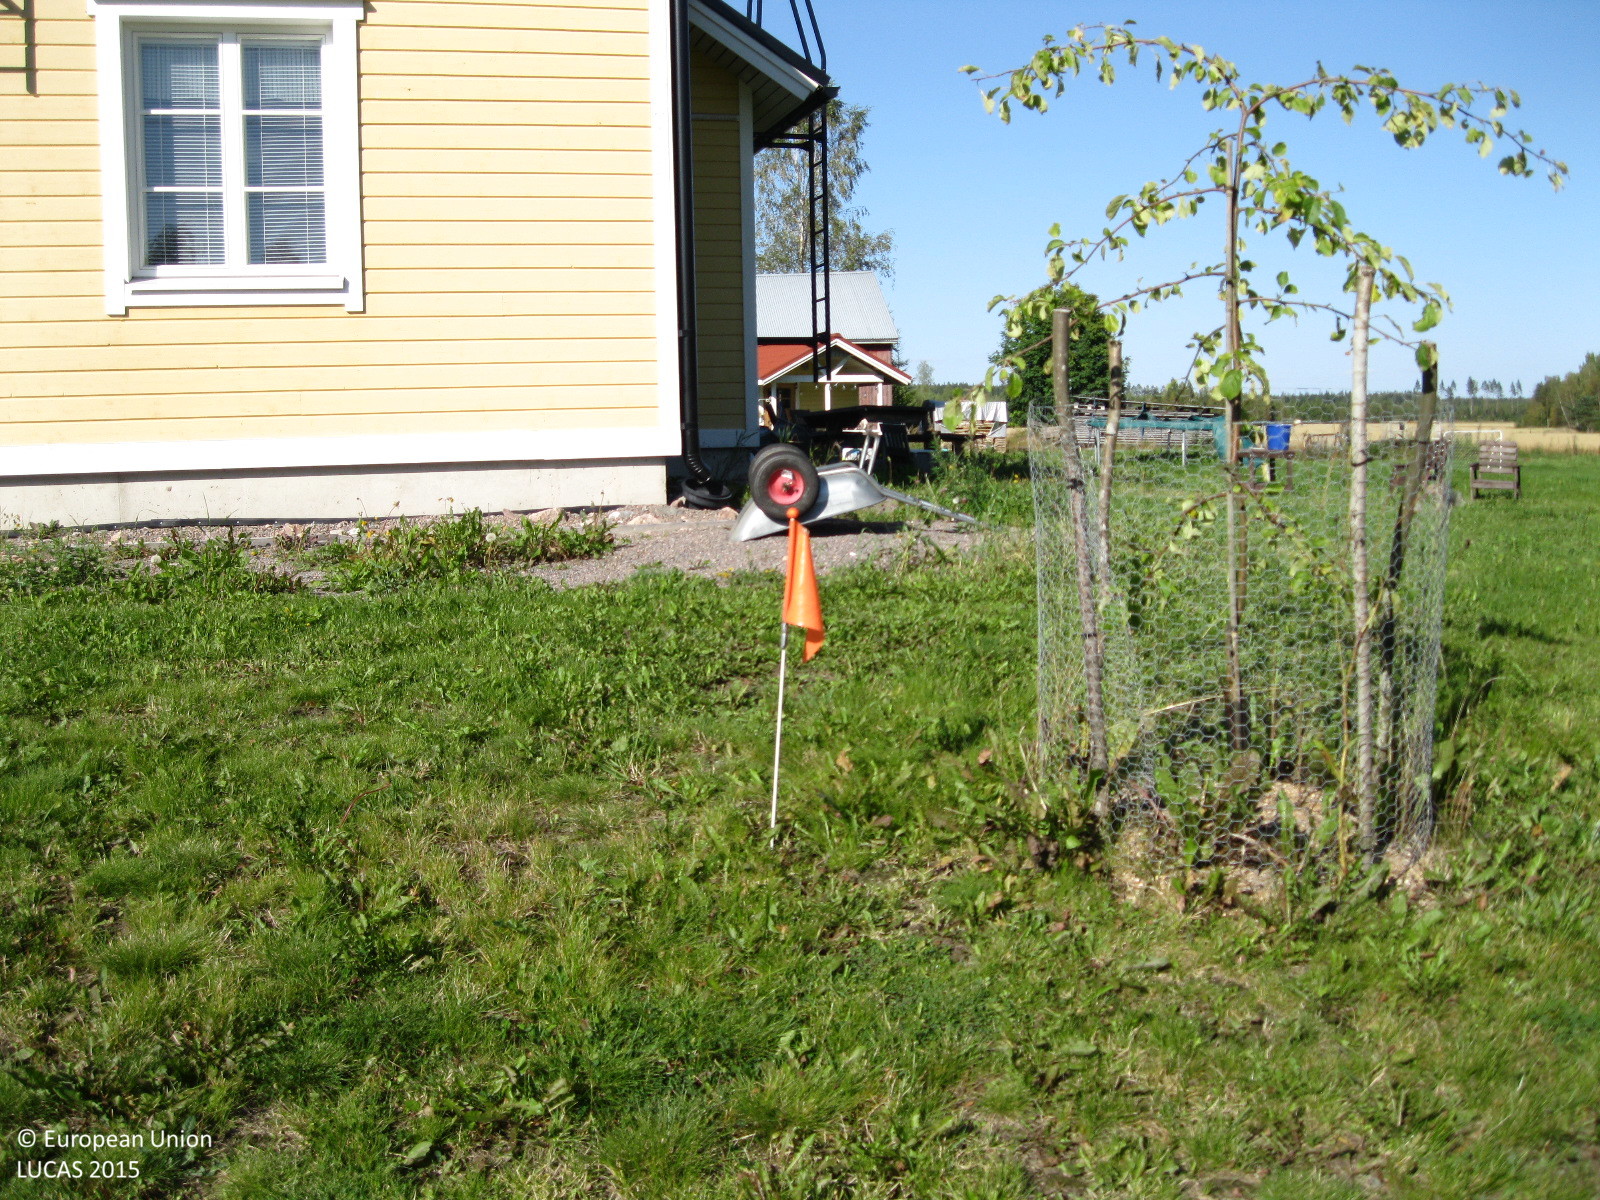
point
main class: Grassland
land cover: Grassland with sparse tree/shrub cover
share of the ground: > 75 %
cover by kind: herbaceous plants 95 %, coniferous forest trees 5 %
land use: Residential
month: September
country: FI
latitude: 60.6595
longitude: 24.9901
